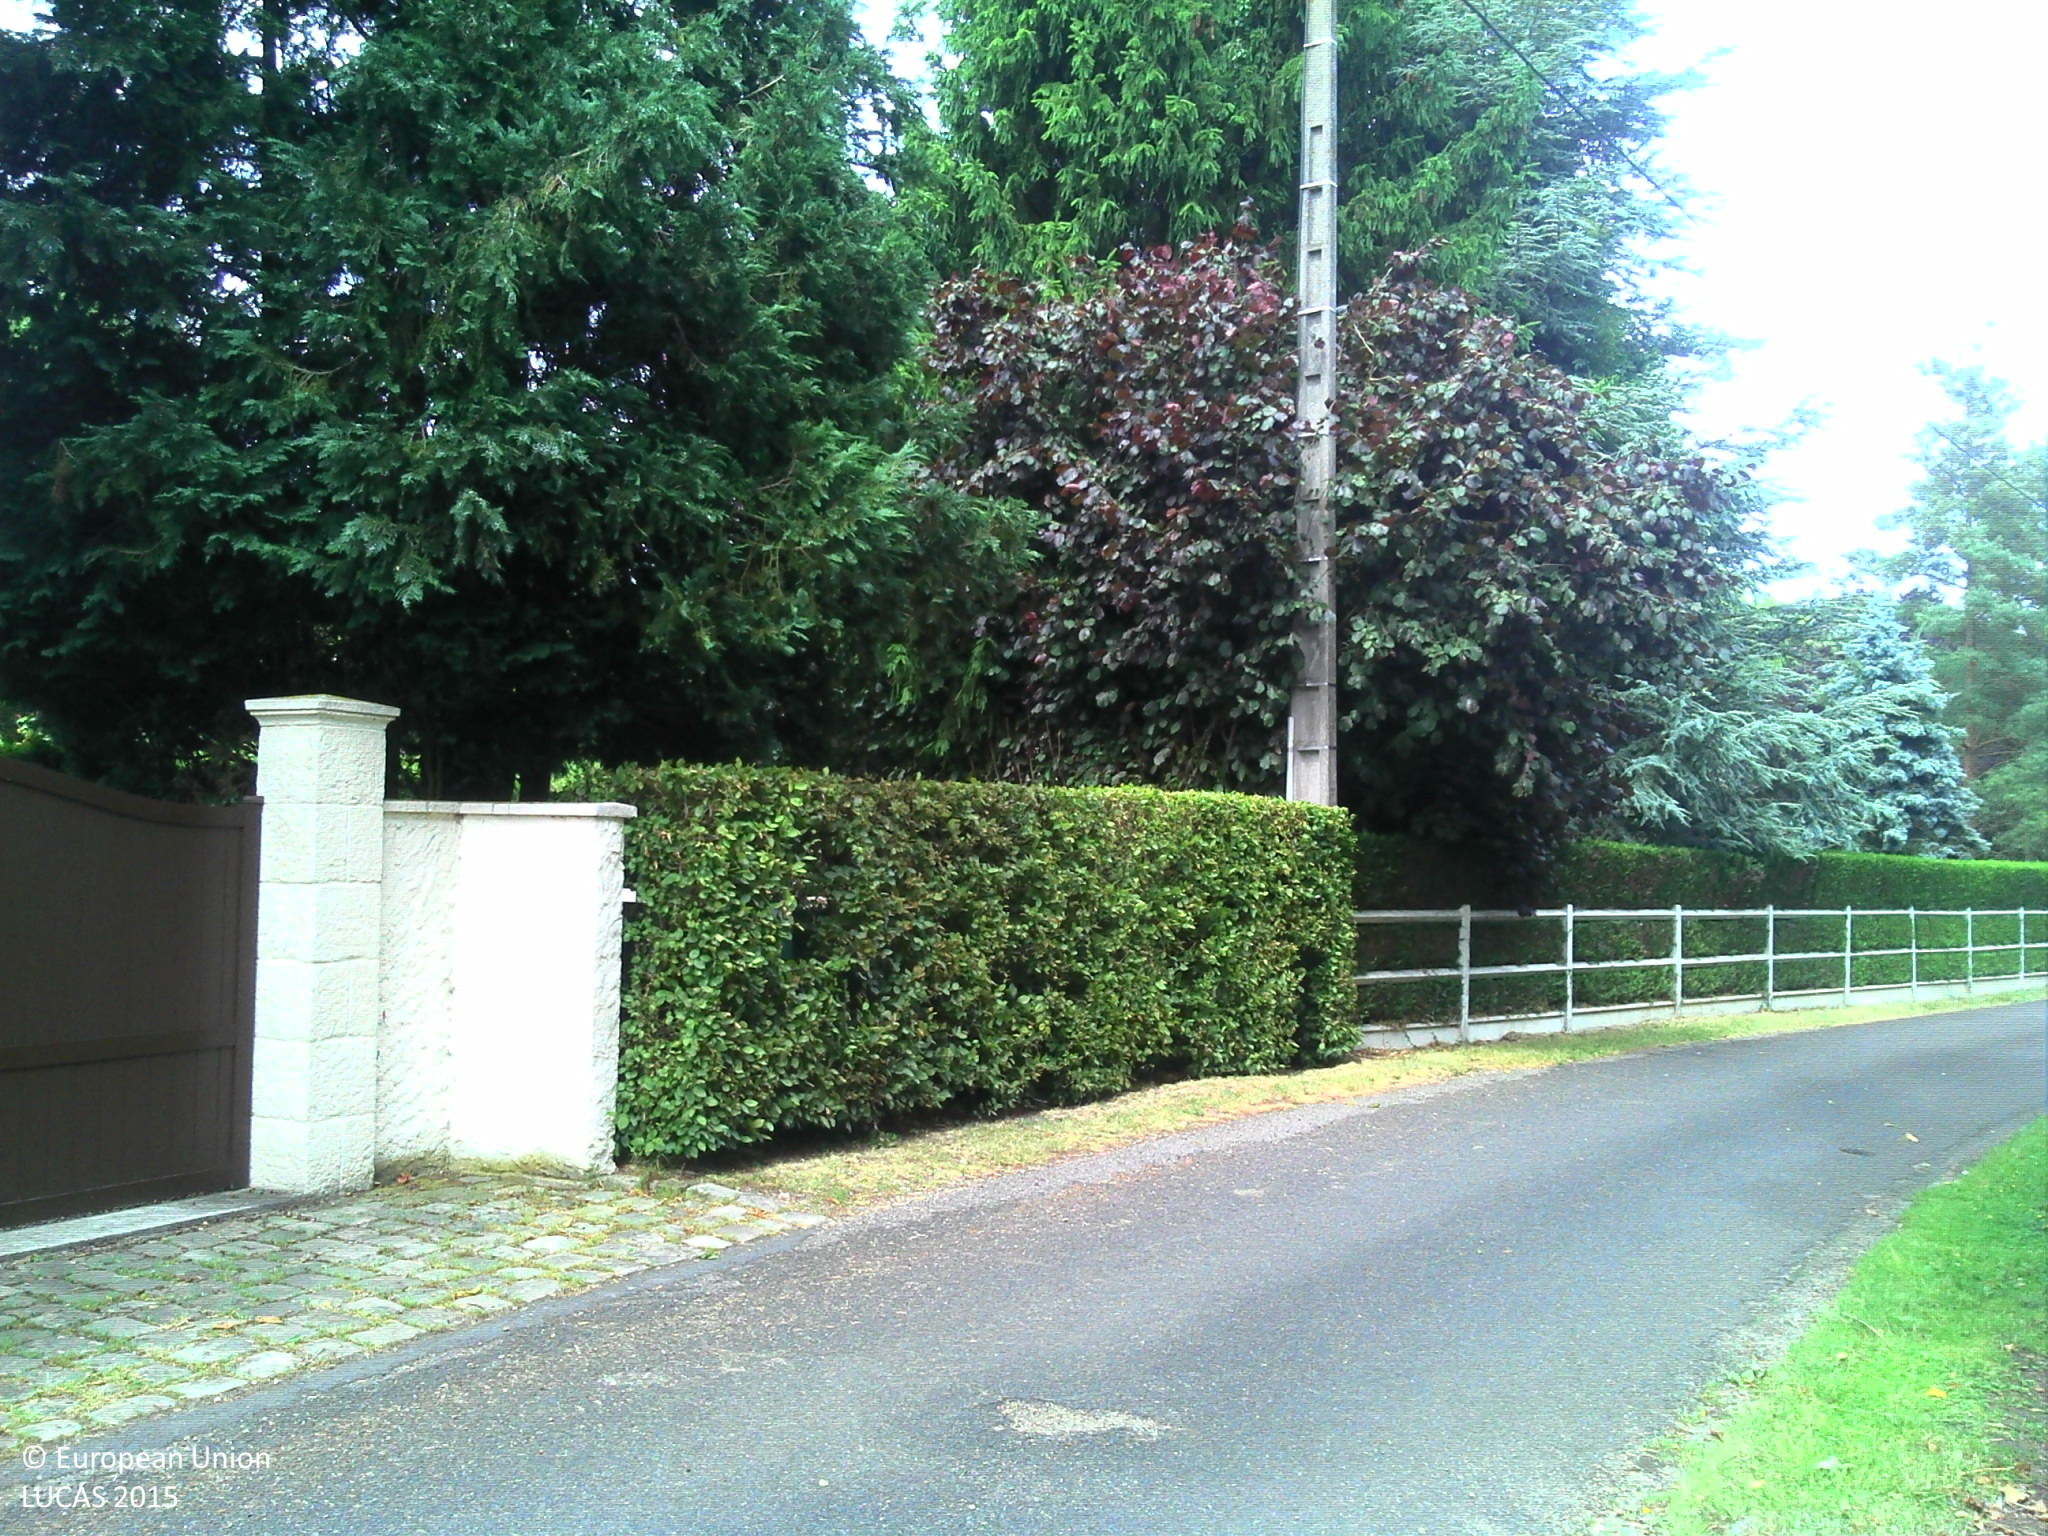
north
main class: Grassland
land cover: Grassland without tree/shrub cover
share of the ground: > 75 %
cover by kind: herbaceous plants 100 %
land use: Residential
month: June
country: FR
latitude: 49.0724
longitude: 1.2882
